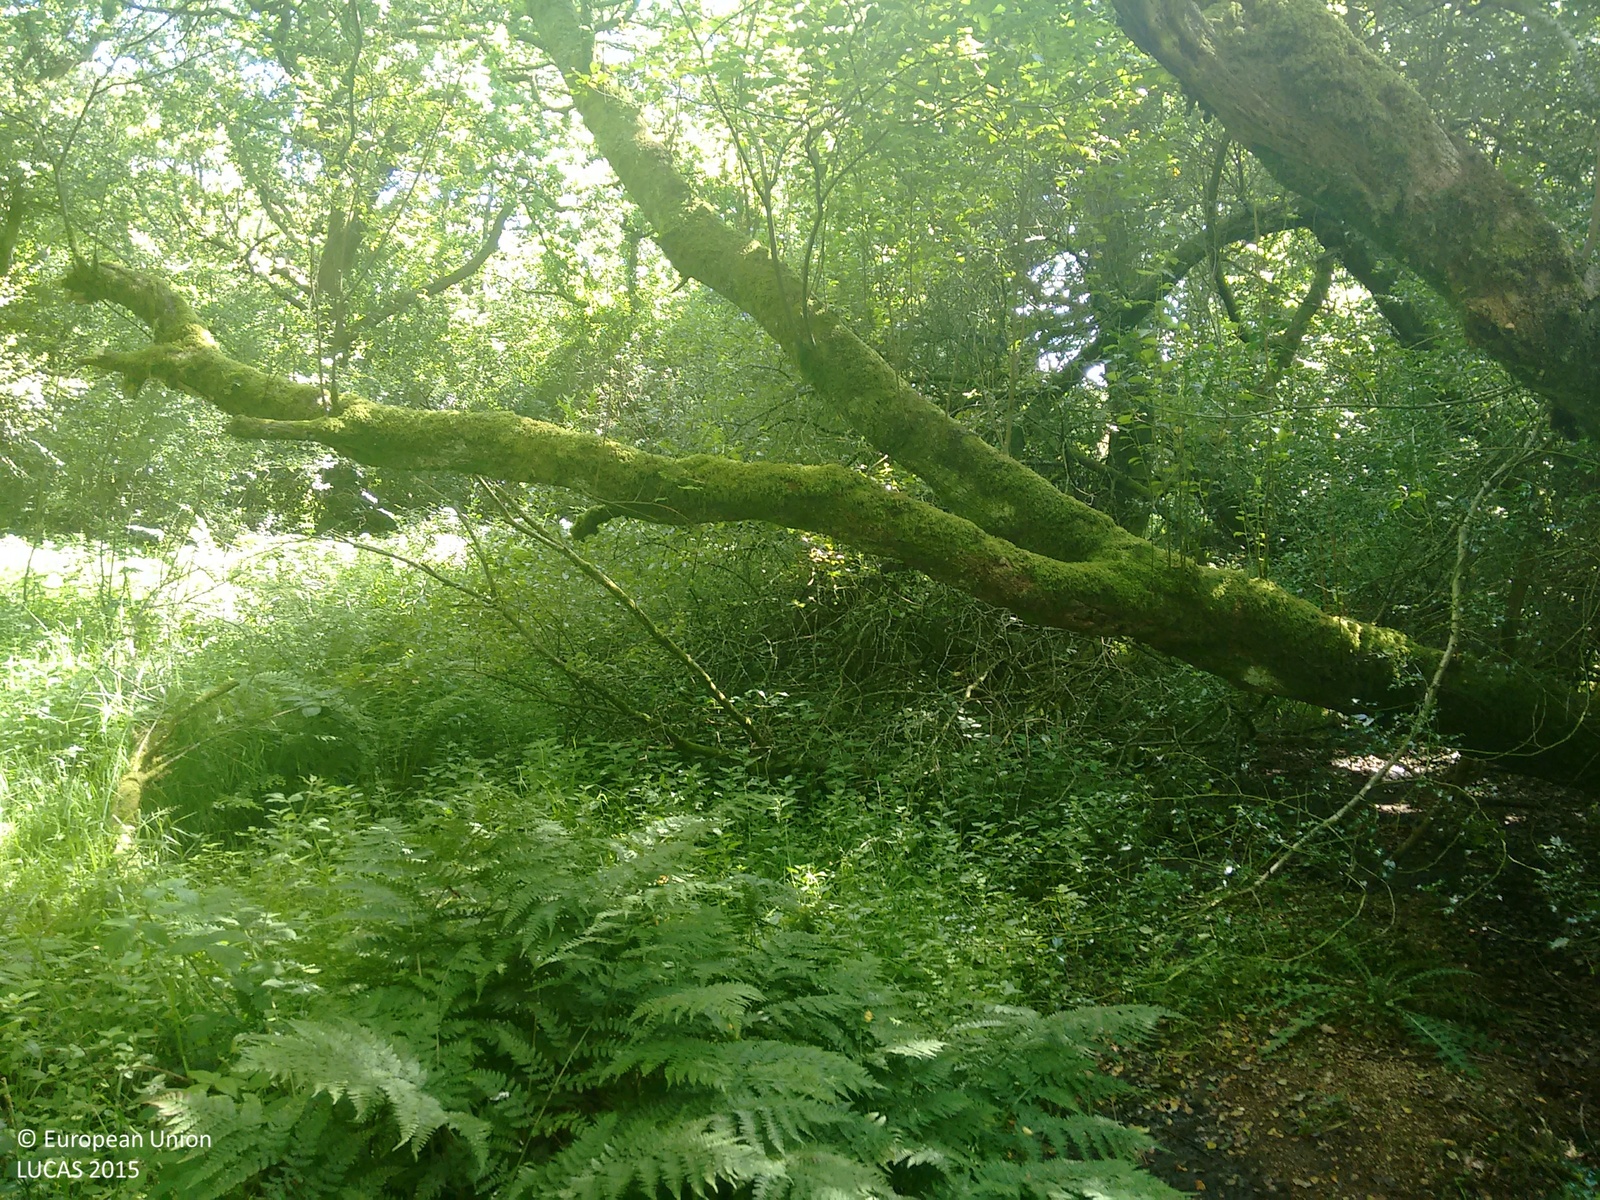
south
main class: Woodland
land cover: Broadleaved woodland
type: mesophytic deciduous forest
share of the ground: > 75 %
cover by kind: broadleaved forest trees 100 %
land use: Semi-natural and natural areas not in use
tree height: > 5 m
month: July
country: GB
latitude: 50.5805
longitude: -3.8026
